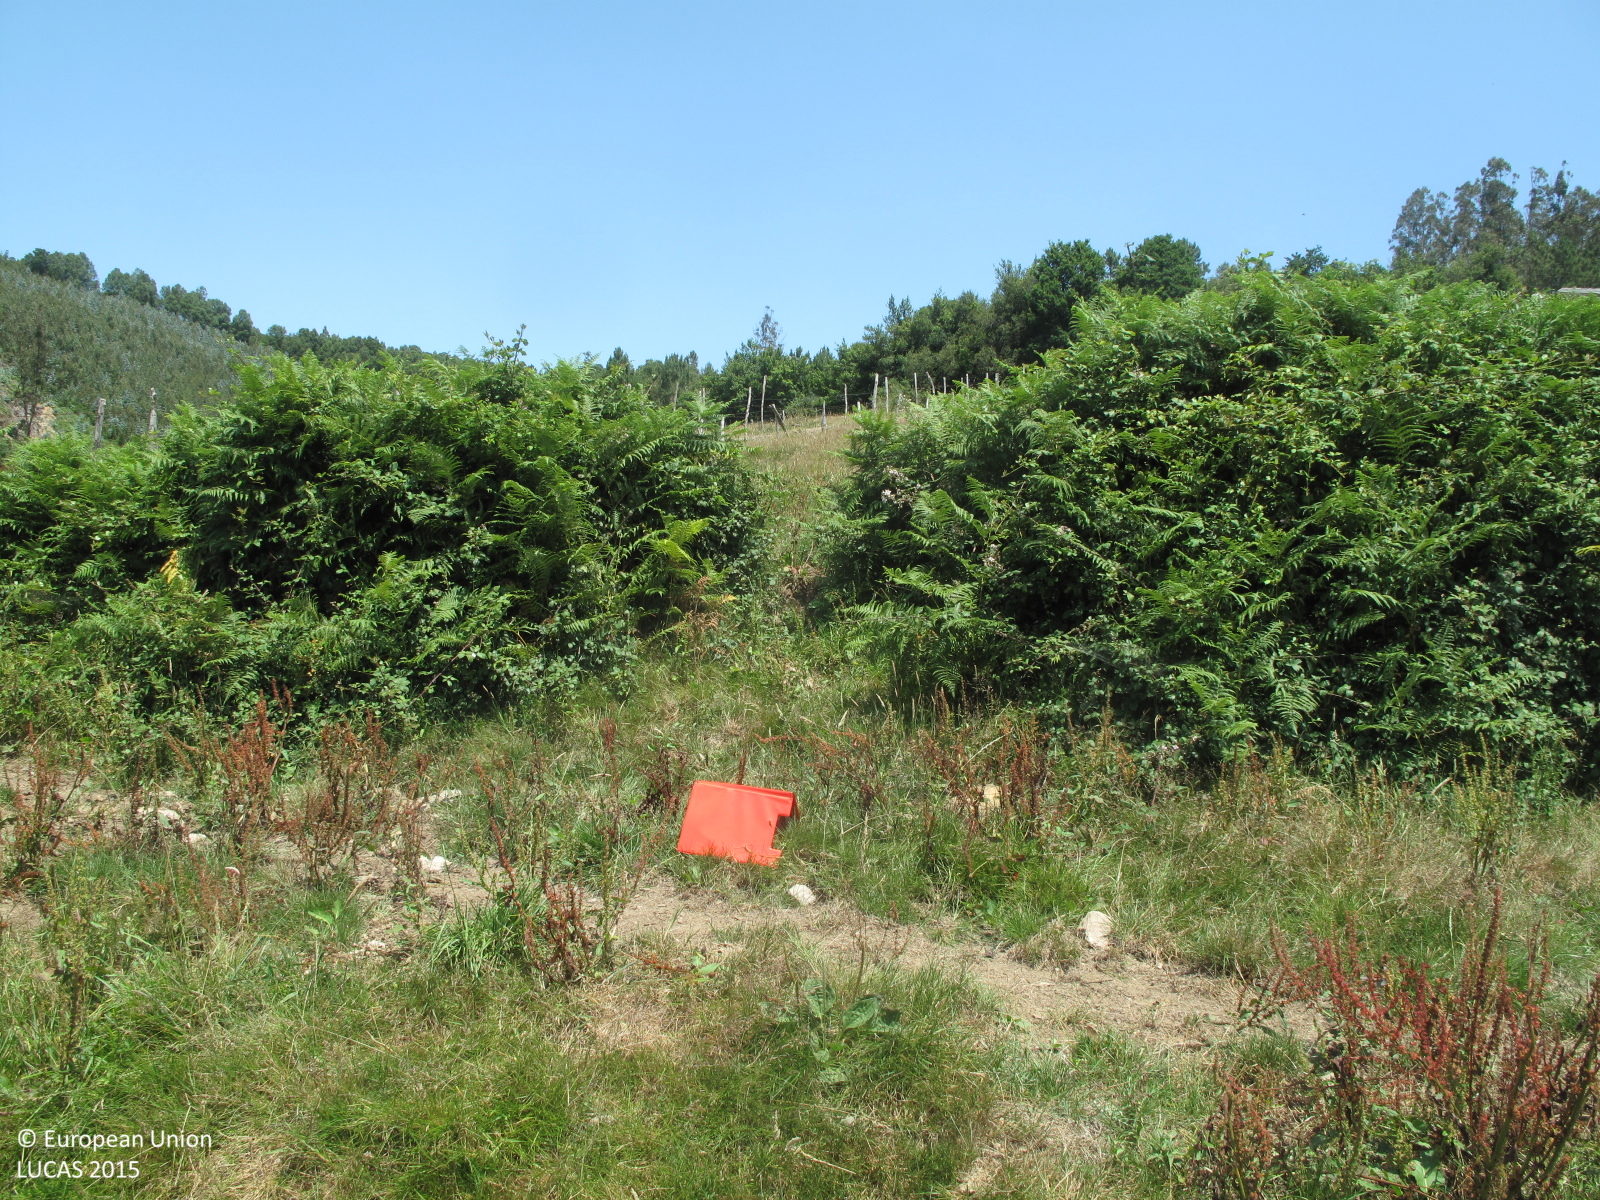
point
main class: Grassland
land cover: Grassland without tree/shrub cover
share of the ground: > 75 %
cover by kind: herbaceous plants 95 %, unconsolidated bare surface 5 %
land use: Agriculture (excluding fallow land and kitchen gardens)
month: July
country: ES
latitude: 43.5605
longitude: -7.8577
